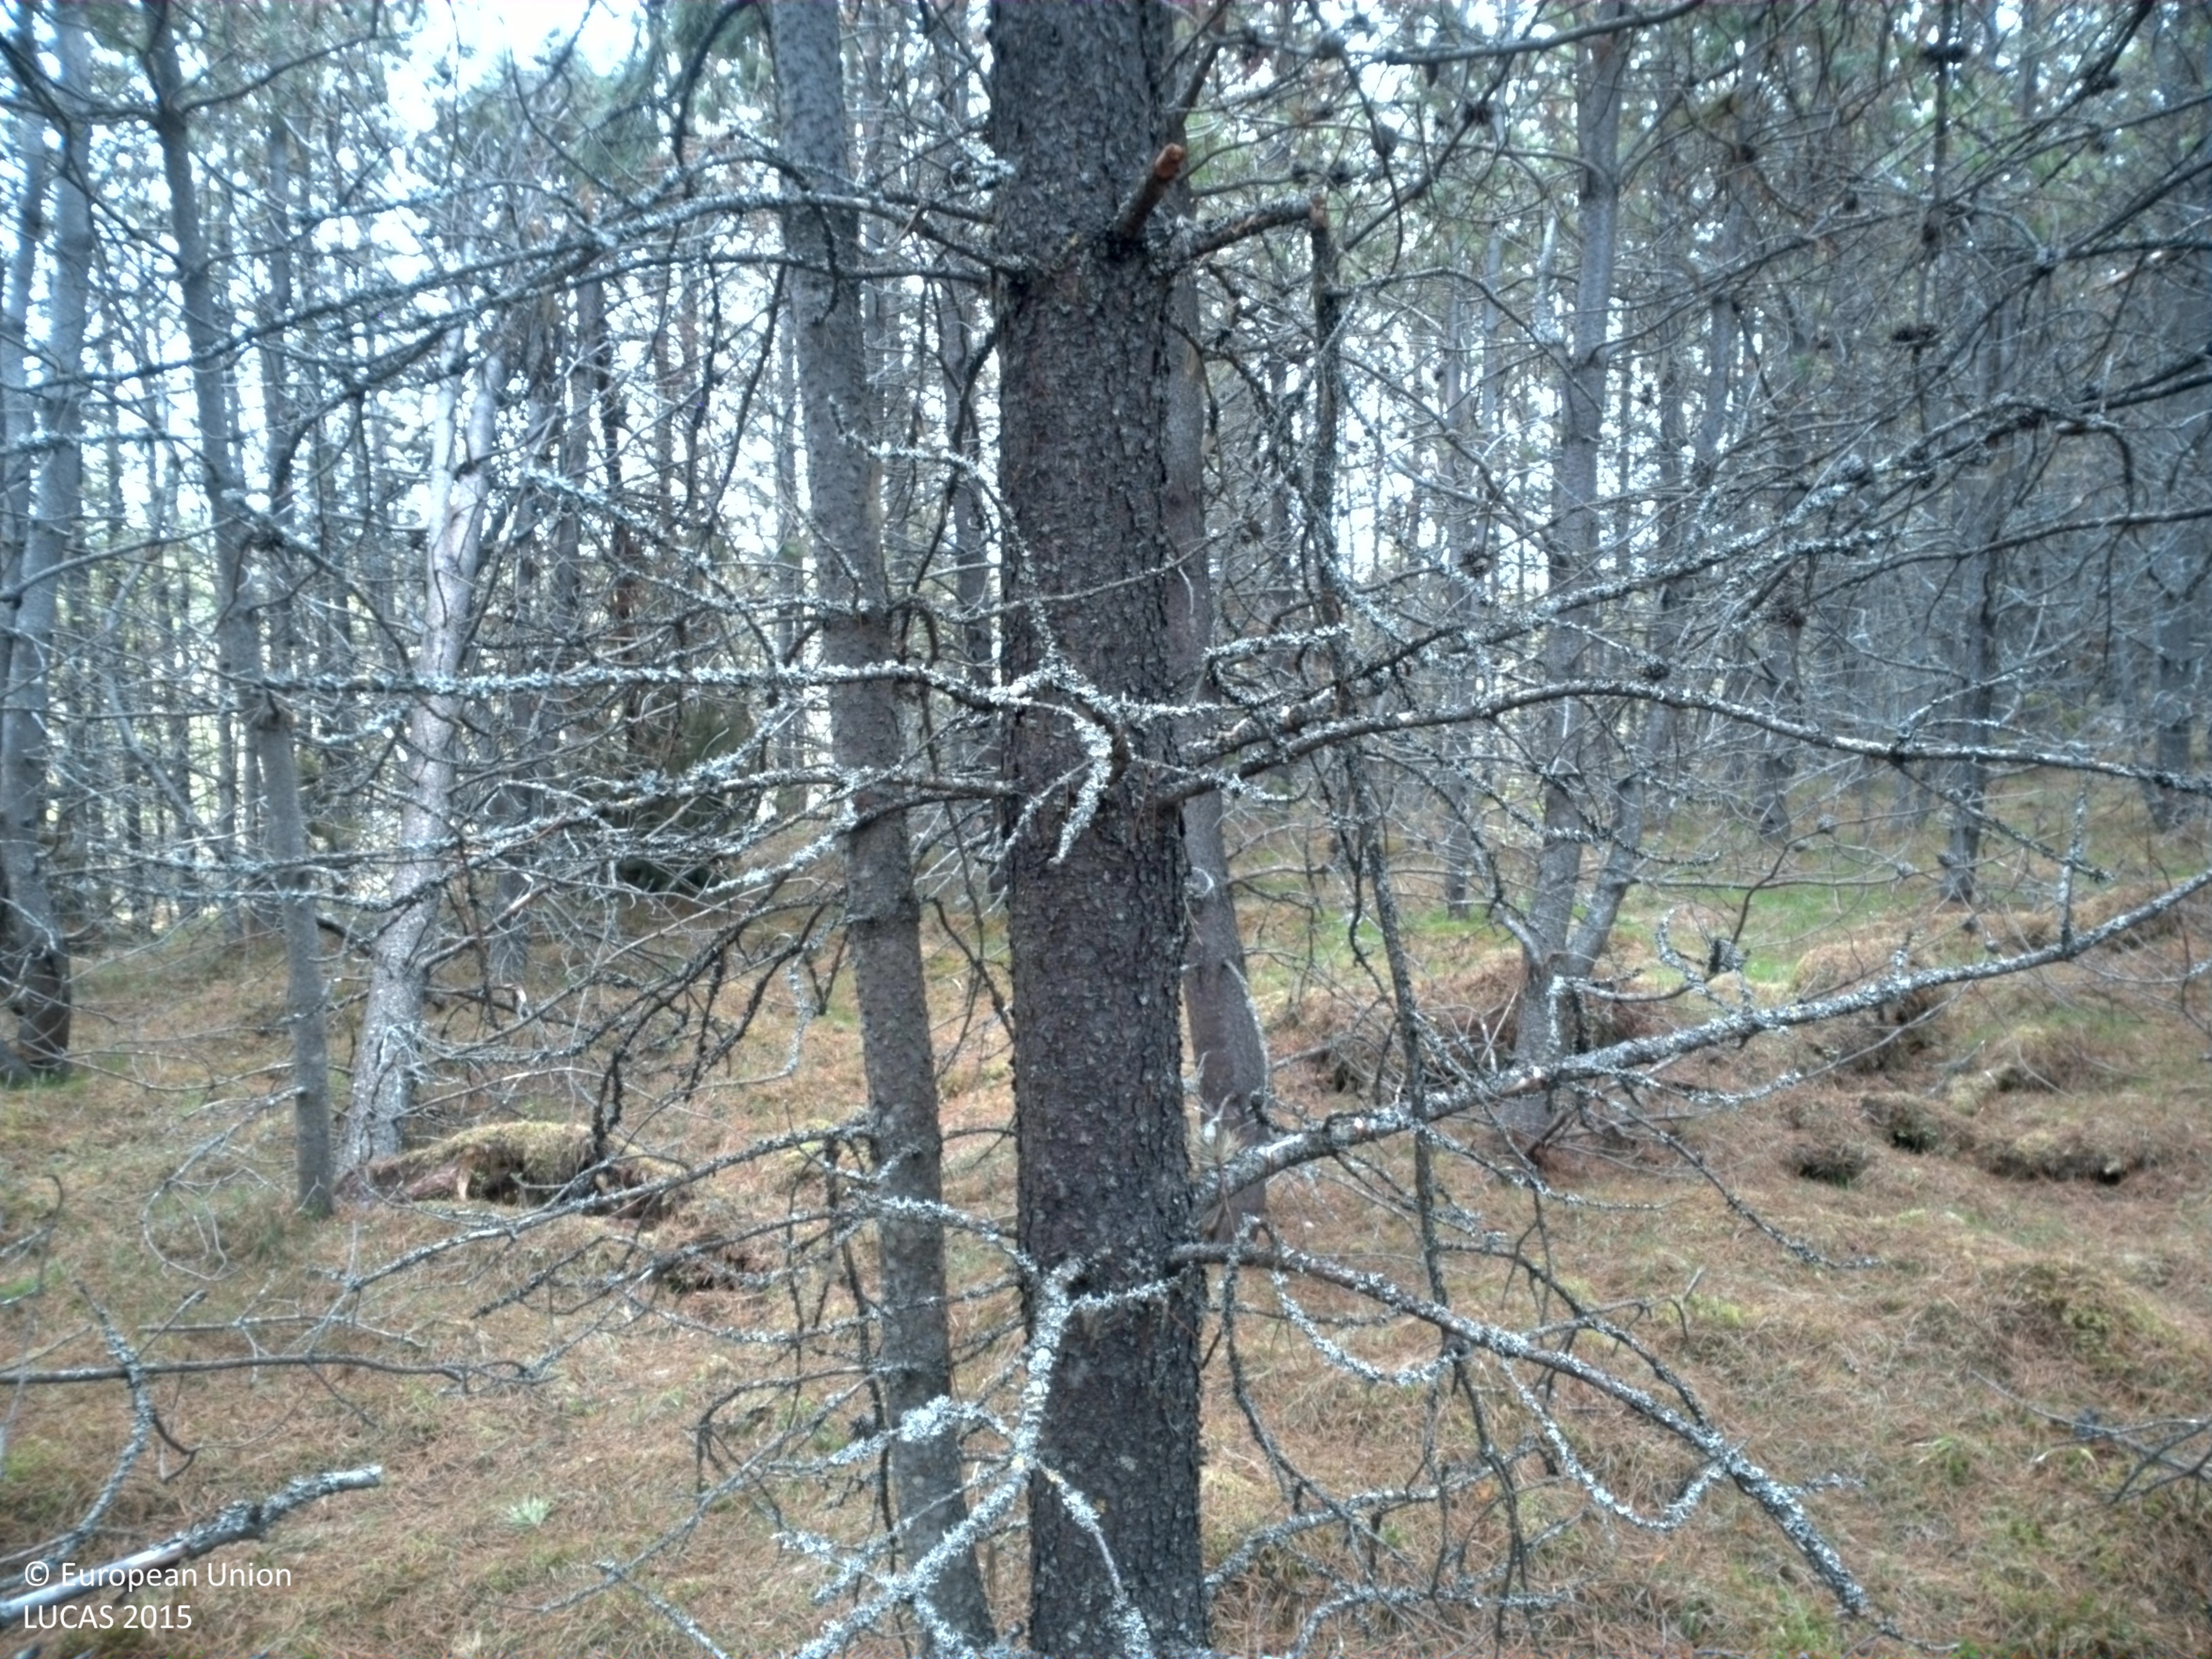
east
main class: Woodland
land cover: Pine dominated coniferous woodland
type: exotic forest
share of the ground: 50 - 75 %
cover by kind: coniferous forest trees 50 %, lichens and mosses 30 %, herbaceous plants 10 %, broadleaved forest trees 5 %, shrubs 5 %
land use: Forestry
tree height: > 5 m
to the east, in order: Pine dominated coniferous woodland; Shrubland with sparse tree cover; Peatbogs; Rocks and stones; Paved roads, cycling and walking lanes; Rocks and stones; Grass margins; Pine dominated coniferous woodland; Pine dominated mixed woodland
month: June
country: SE
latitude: 64.3108
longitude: 17.5151
